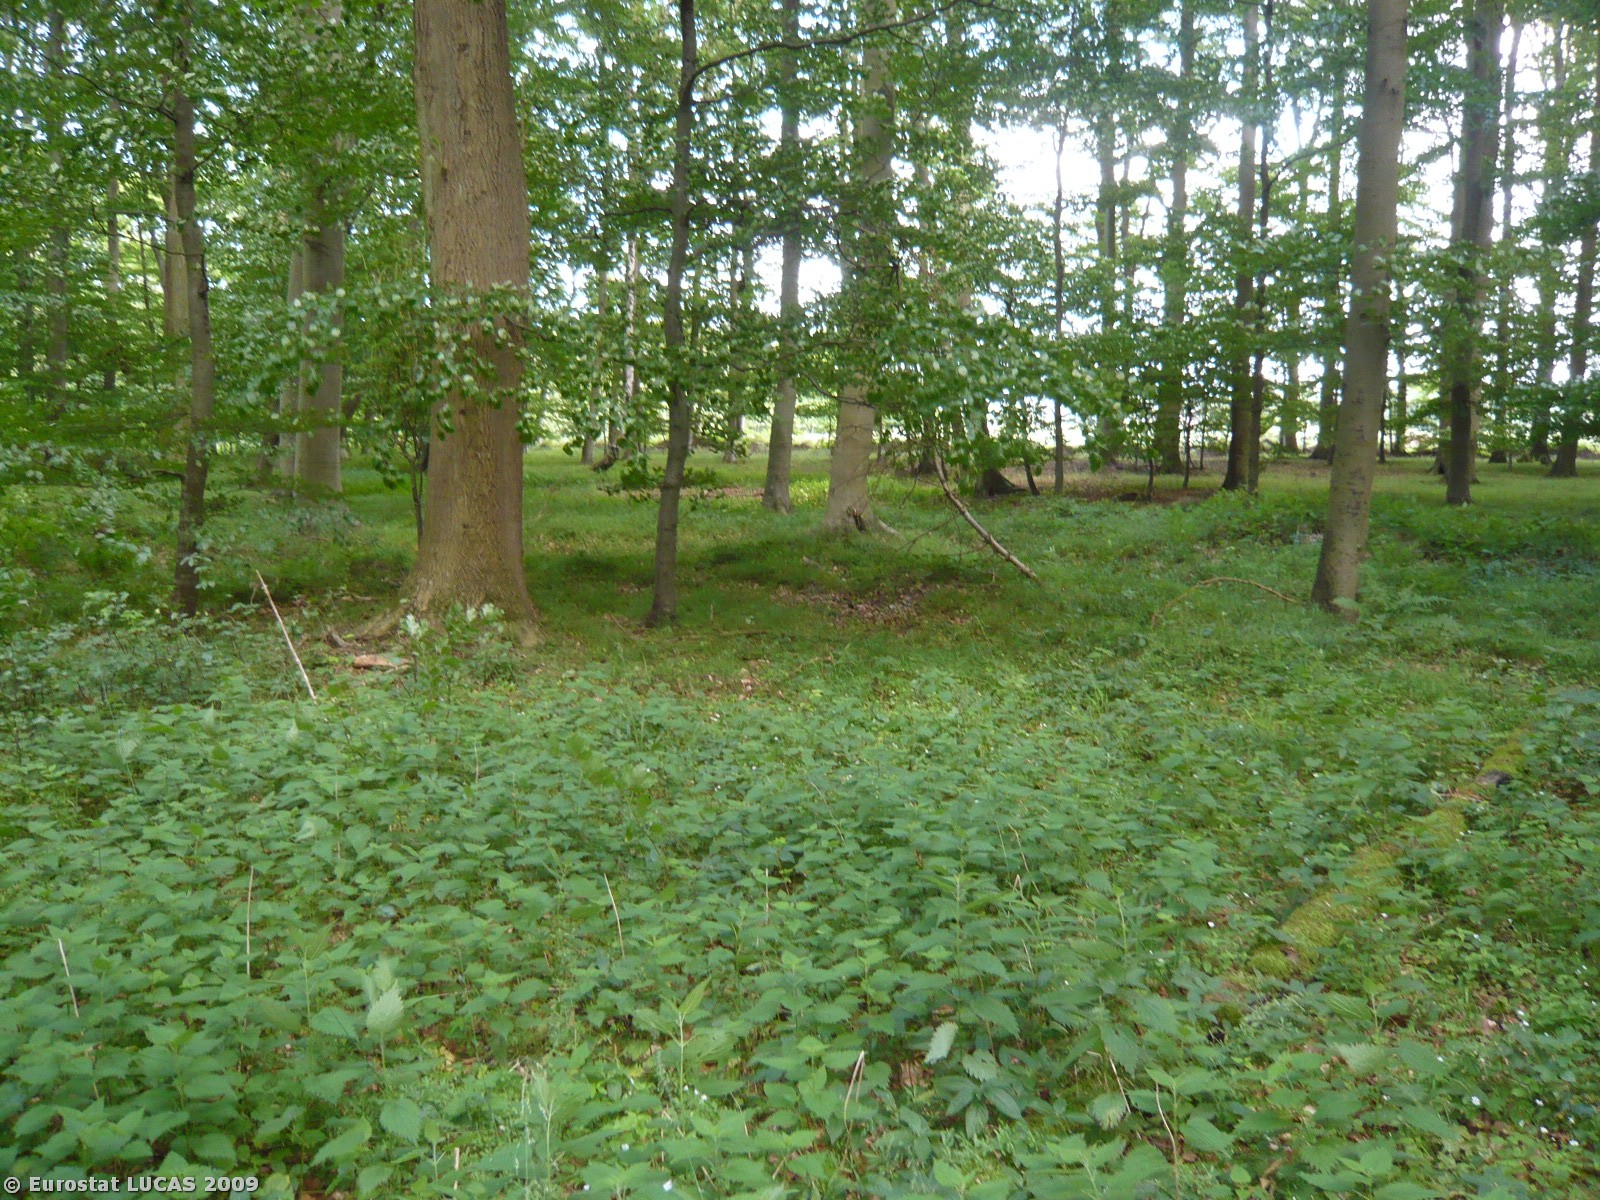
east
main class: Woodland
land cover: Broadleaved woodland
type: mesophytic deciduous forest
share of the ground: > 75 %
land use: Forestry
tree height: > 5 m
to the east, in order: Broadleaved woodland; Ditches and canals; Broadleaved woodland; Inland water bodies; Coniferous woodland; Fences; Grassland without tree/shrub cover; Fences; Common wheat; Fences; Sugar beet
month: June
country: DK
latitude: 54.8686
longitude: 11.3235
